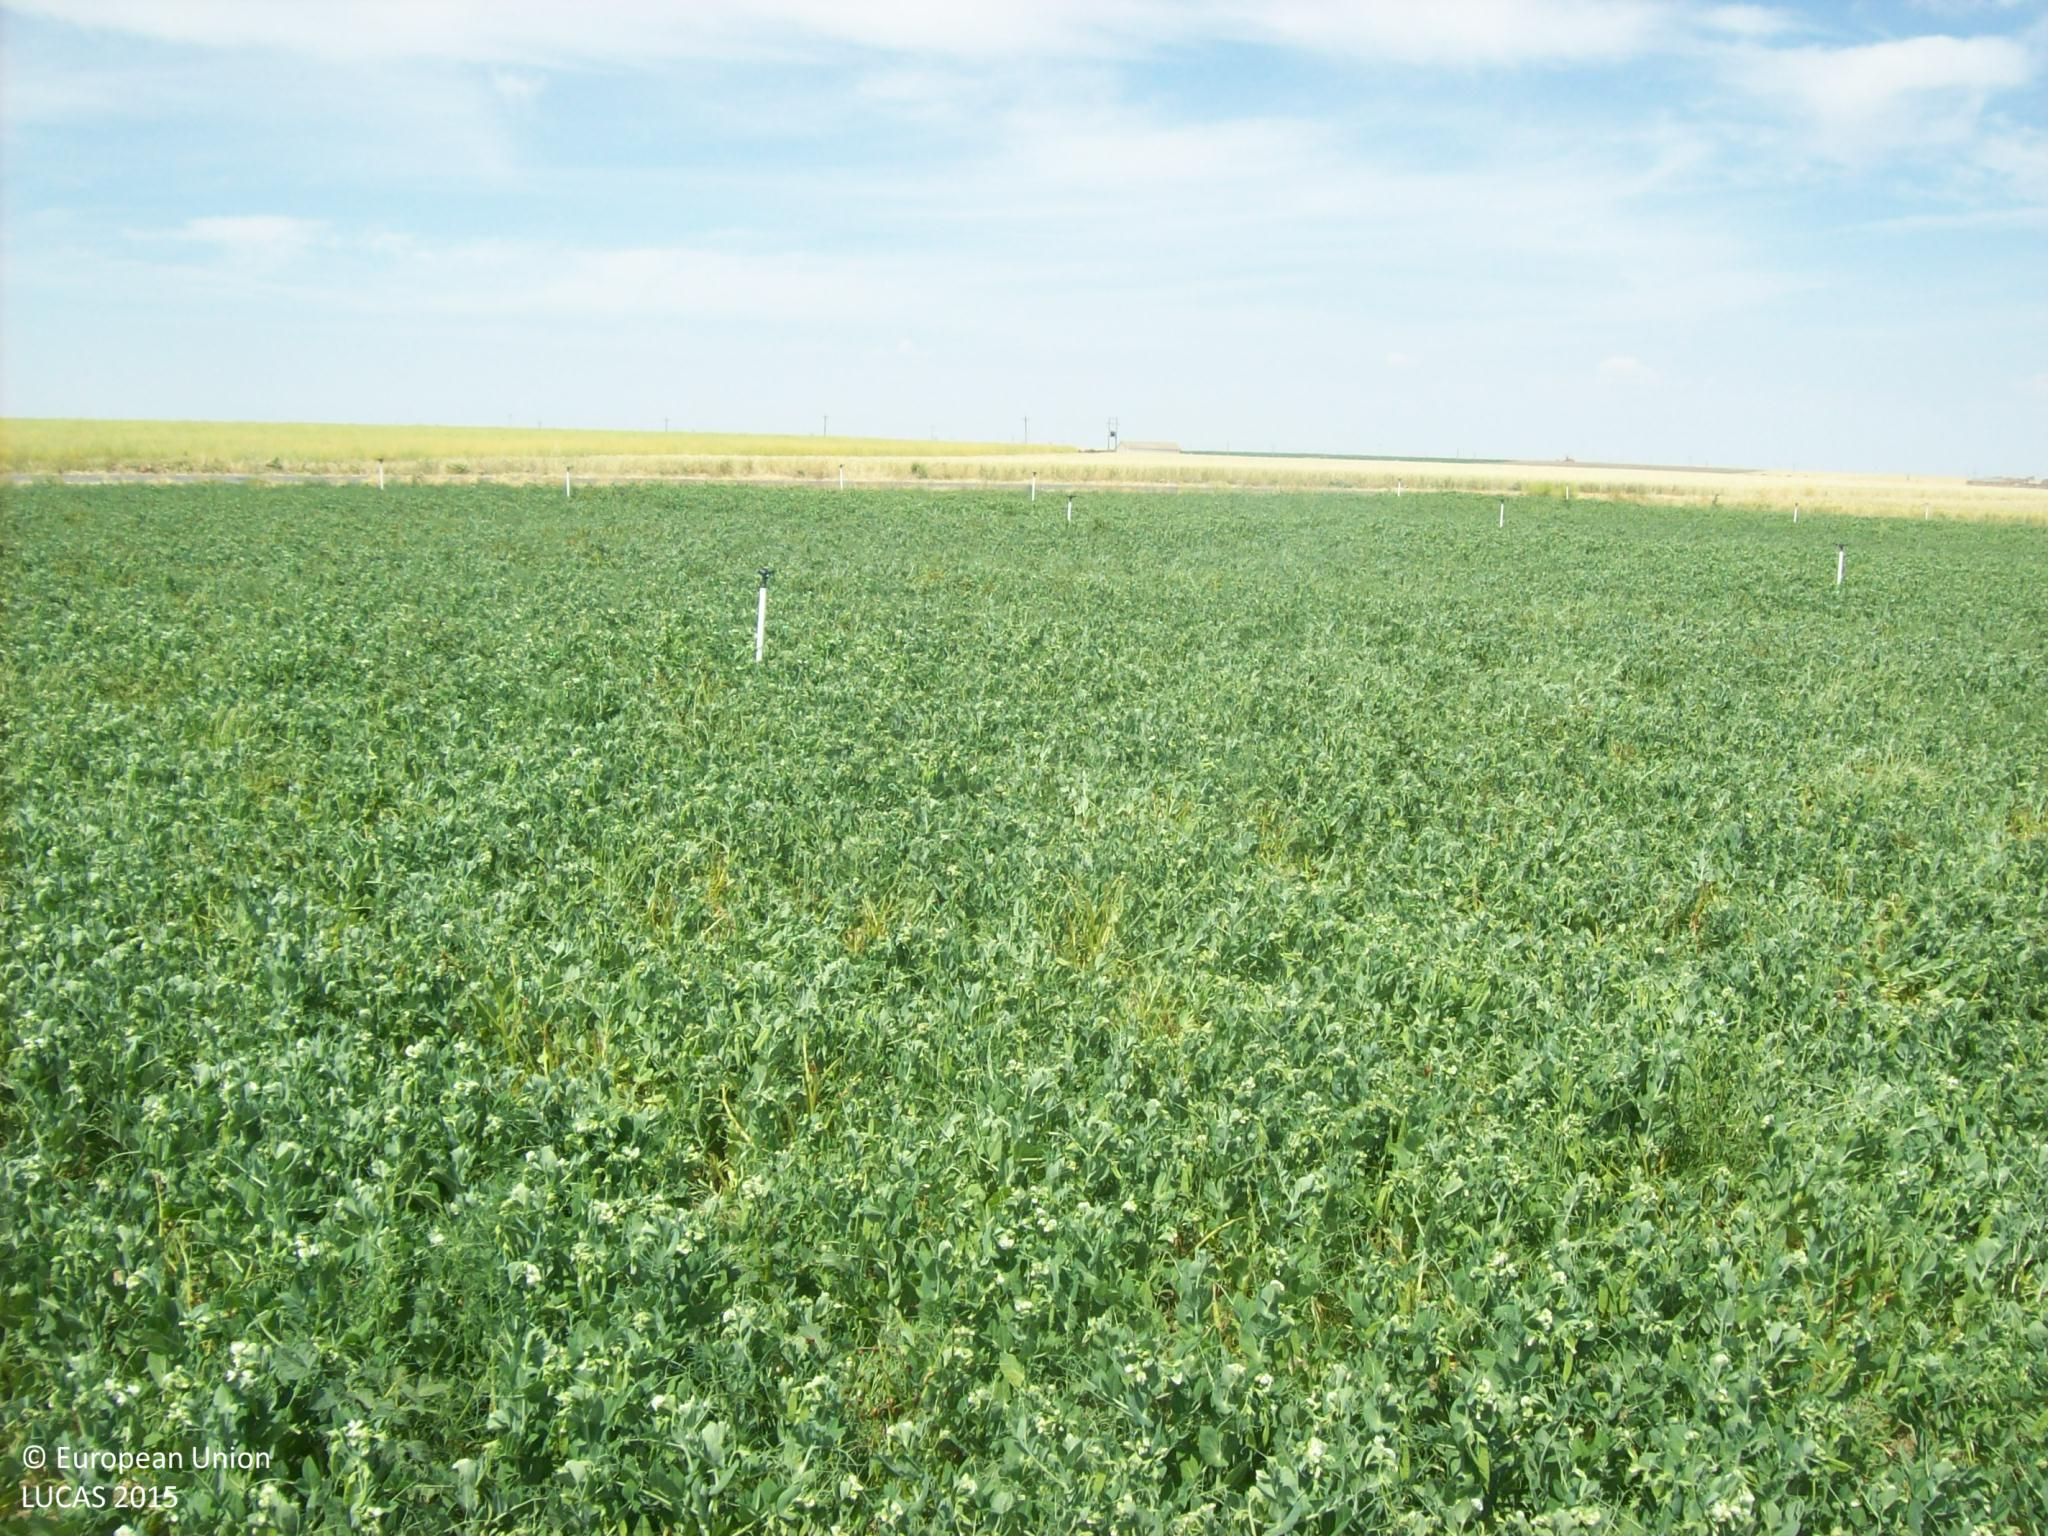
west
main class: Cropland
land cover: Dry pulses
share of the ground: > 75 %
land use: Agriculture (excluding fallow land and kitchen gardens)
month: June
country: ES
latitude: 41.0743
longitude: -4.9790
